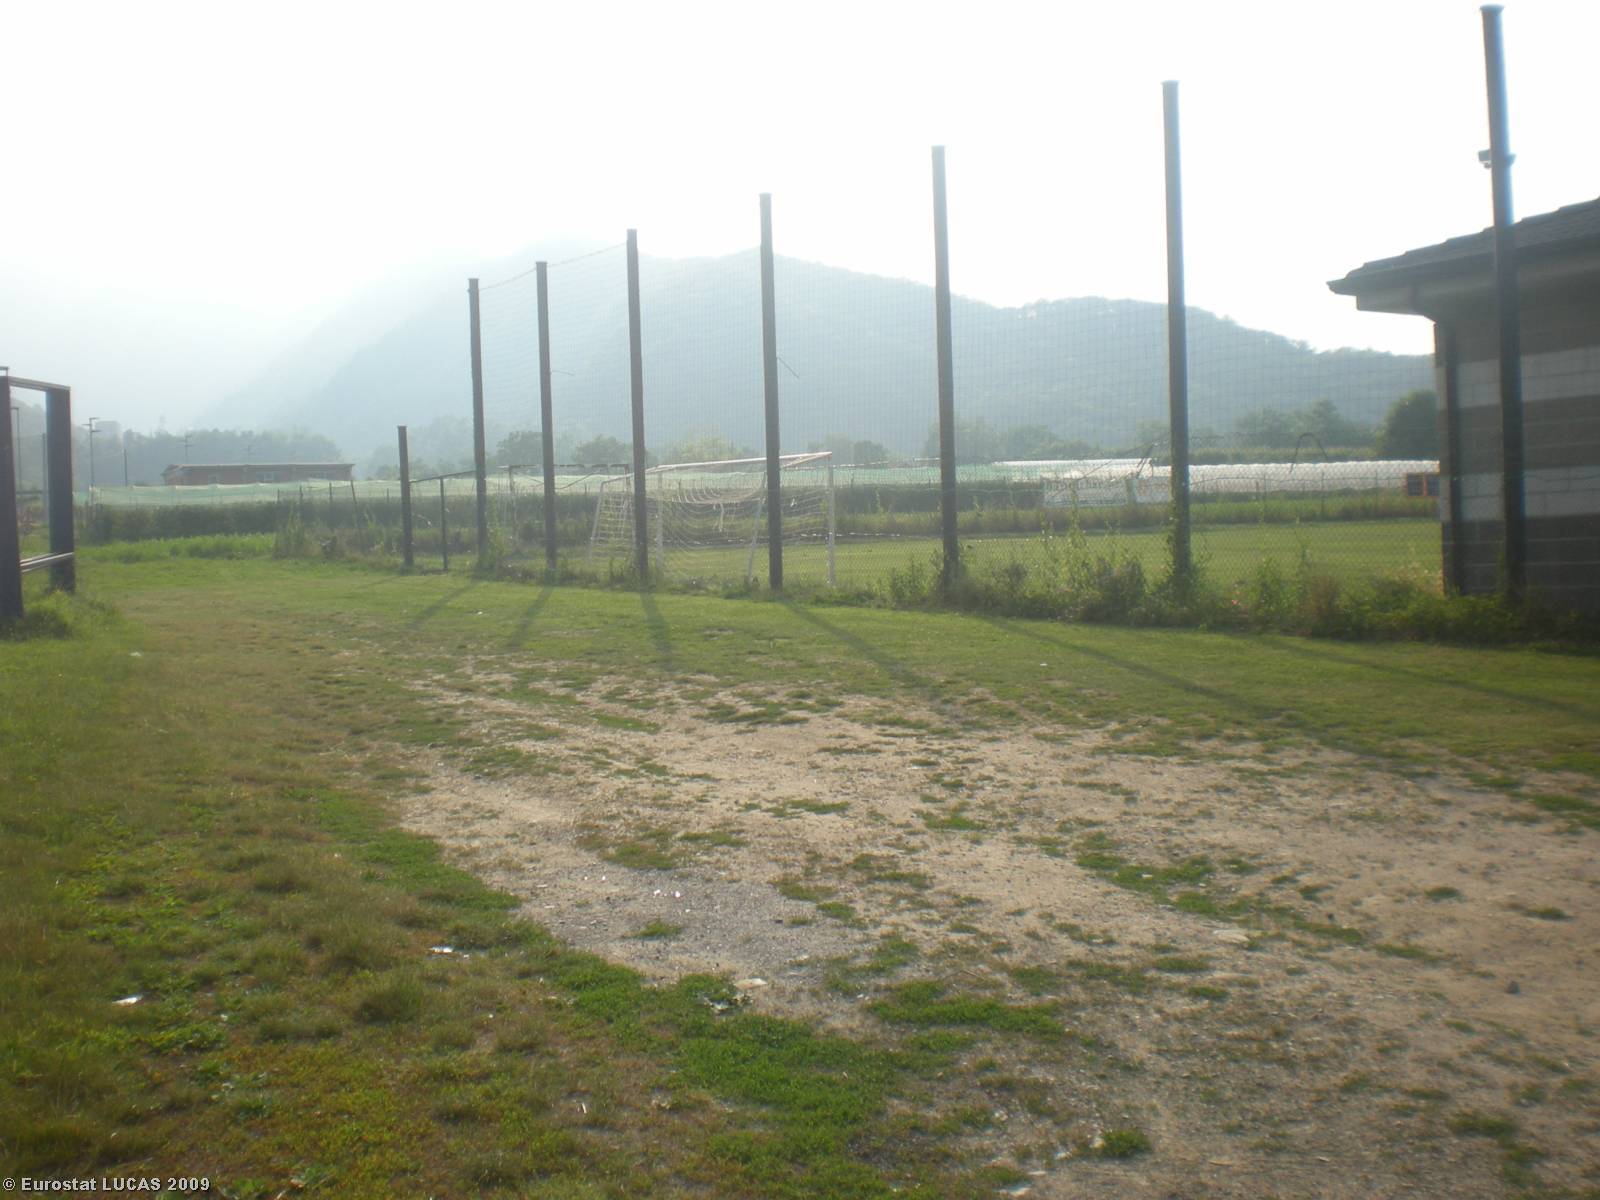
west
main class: Bare land
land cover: Bare land
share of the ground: > 75 %
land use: Residential
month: June
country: IT
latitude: 44.3910
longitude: 7.4319
